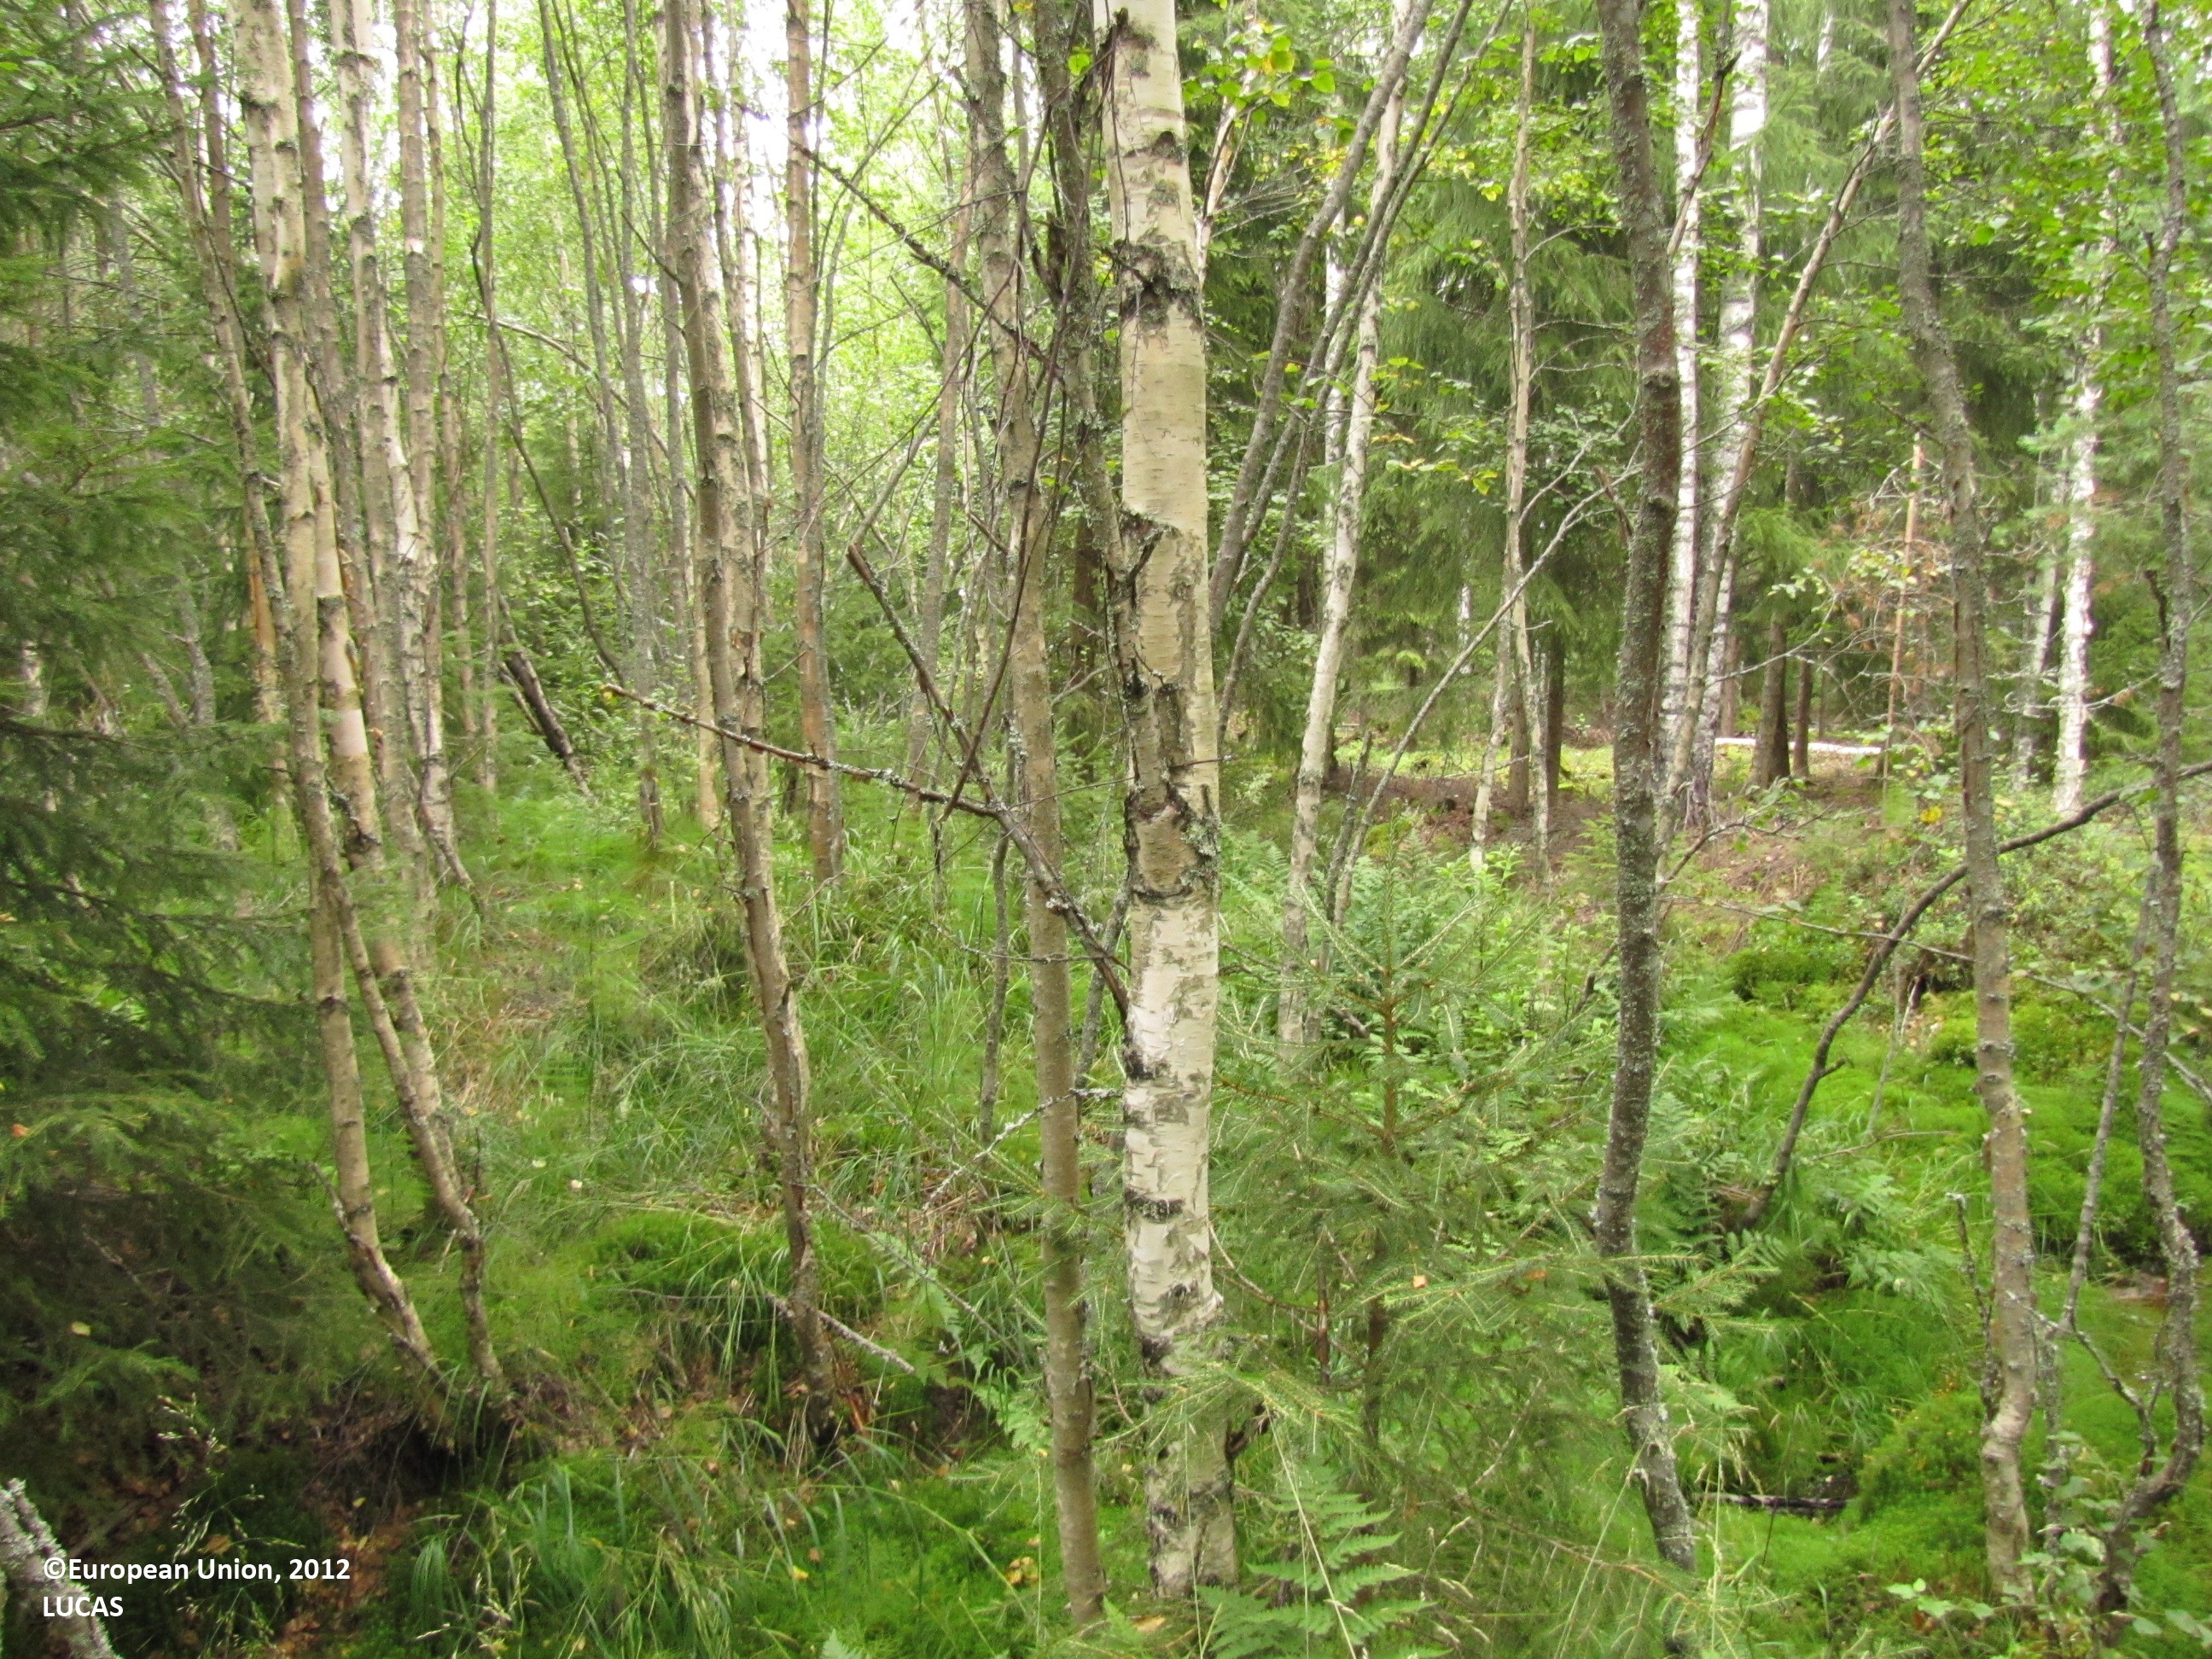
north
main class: Woodland
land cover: Broadleaved woodland
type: mire and swamp forests
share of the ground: 50 - 75 %
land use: Forestry
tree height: > 5 m
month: August
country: FI
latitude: 61.9211
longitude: 22.9603
